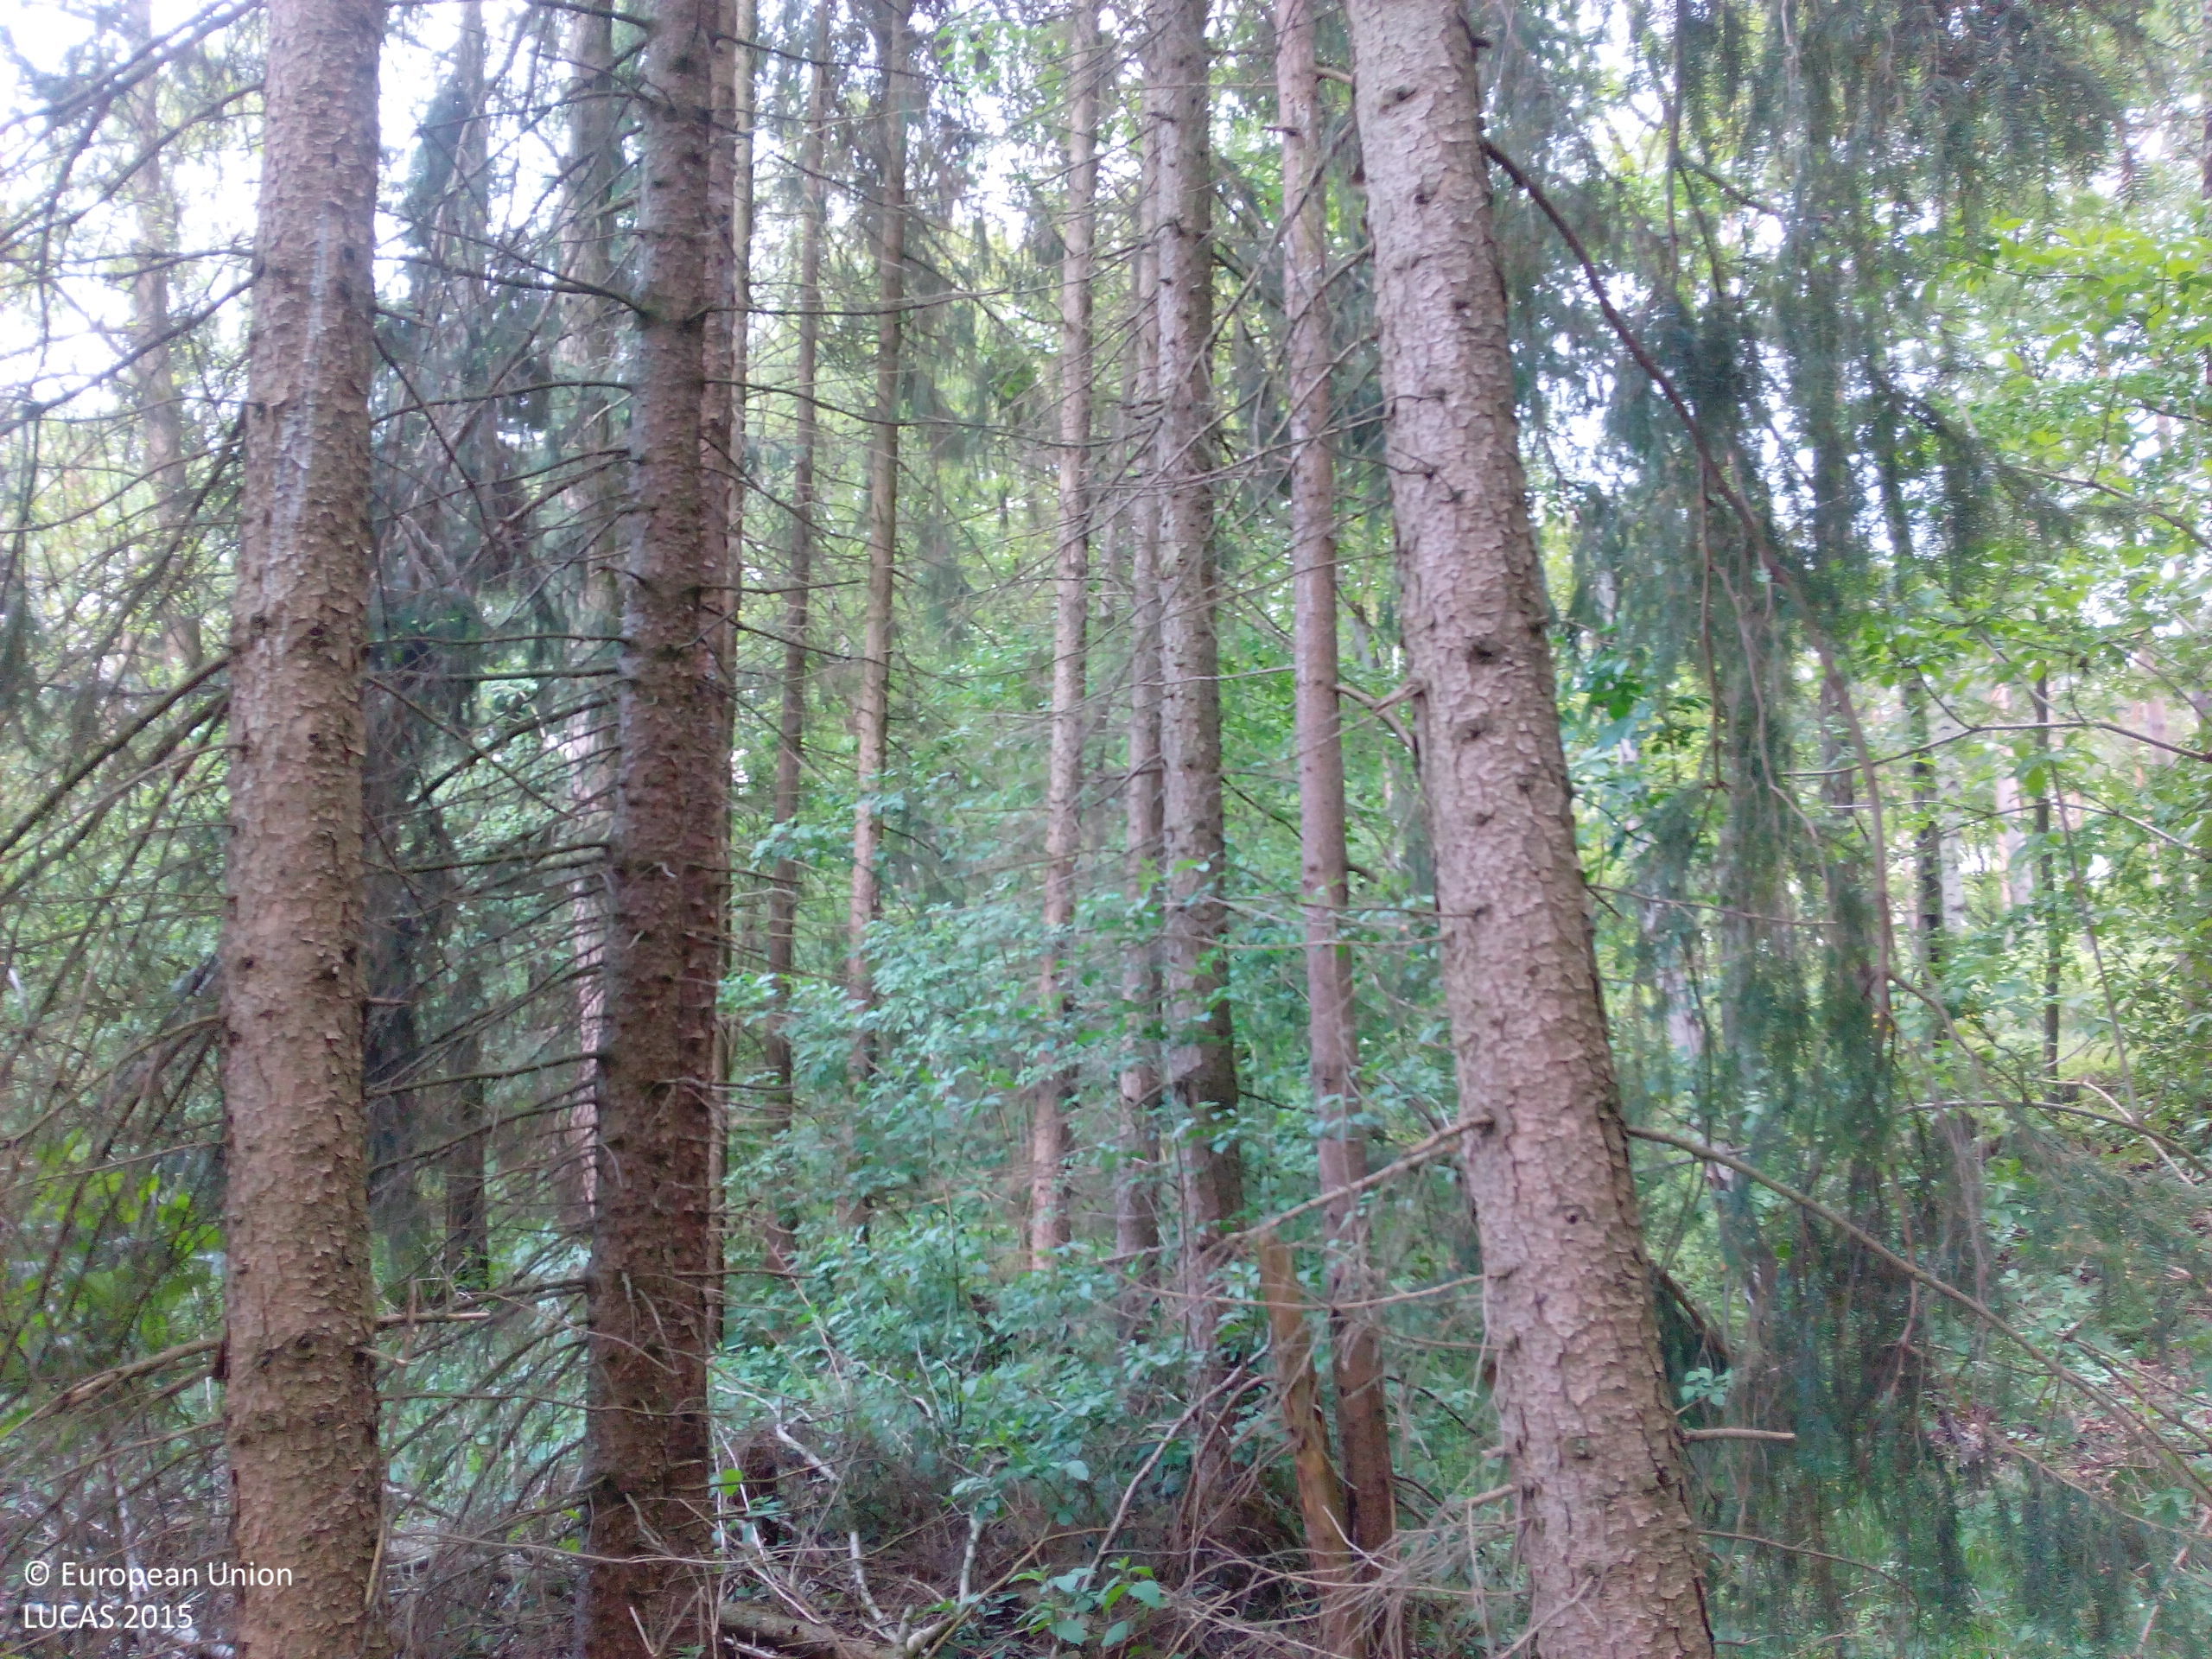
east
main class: Woodland
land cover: Other mixed woodland
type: mire and swamp forests
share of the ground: > 75 %
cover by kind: coniferous forest trees 45 %, broadleaved forest trees 40 %, herbaceous plants 10 %, shrubs 5 %
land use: Forestry
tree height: > 5 m
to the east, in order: Other mixed woodland; Ditches and canals; Other mixed woodland; Inland marshes; Other mixed woodland; Ditches and canals; Spontaneously vegetated surfaces; Common wheat
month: May
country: DE
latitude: 52.2240
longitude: 7.4385
